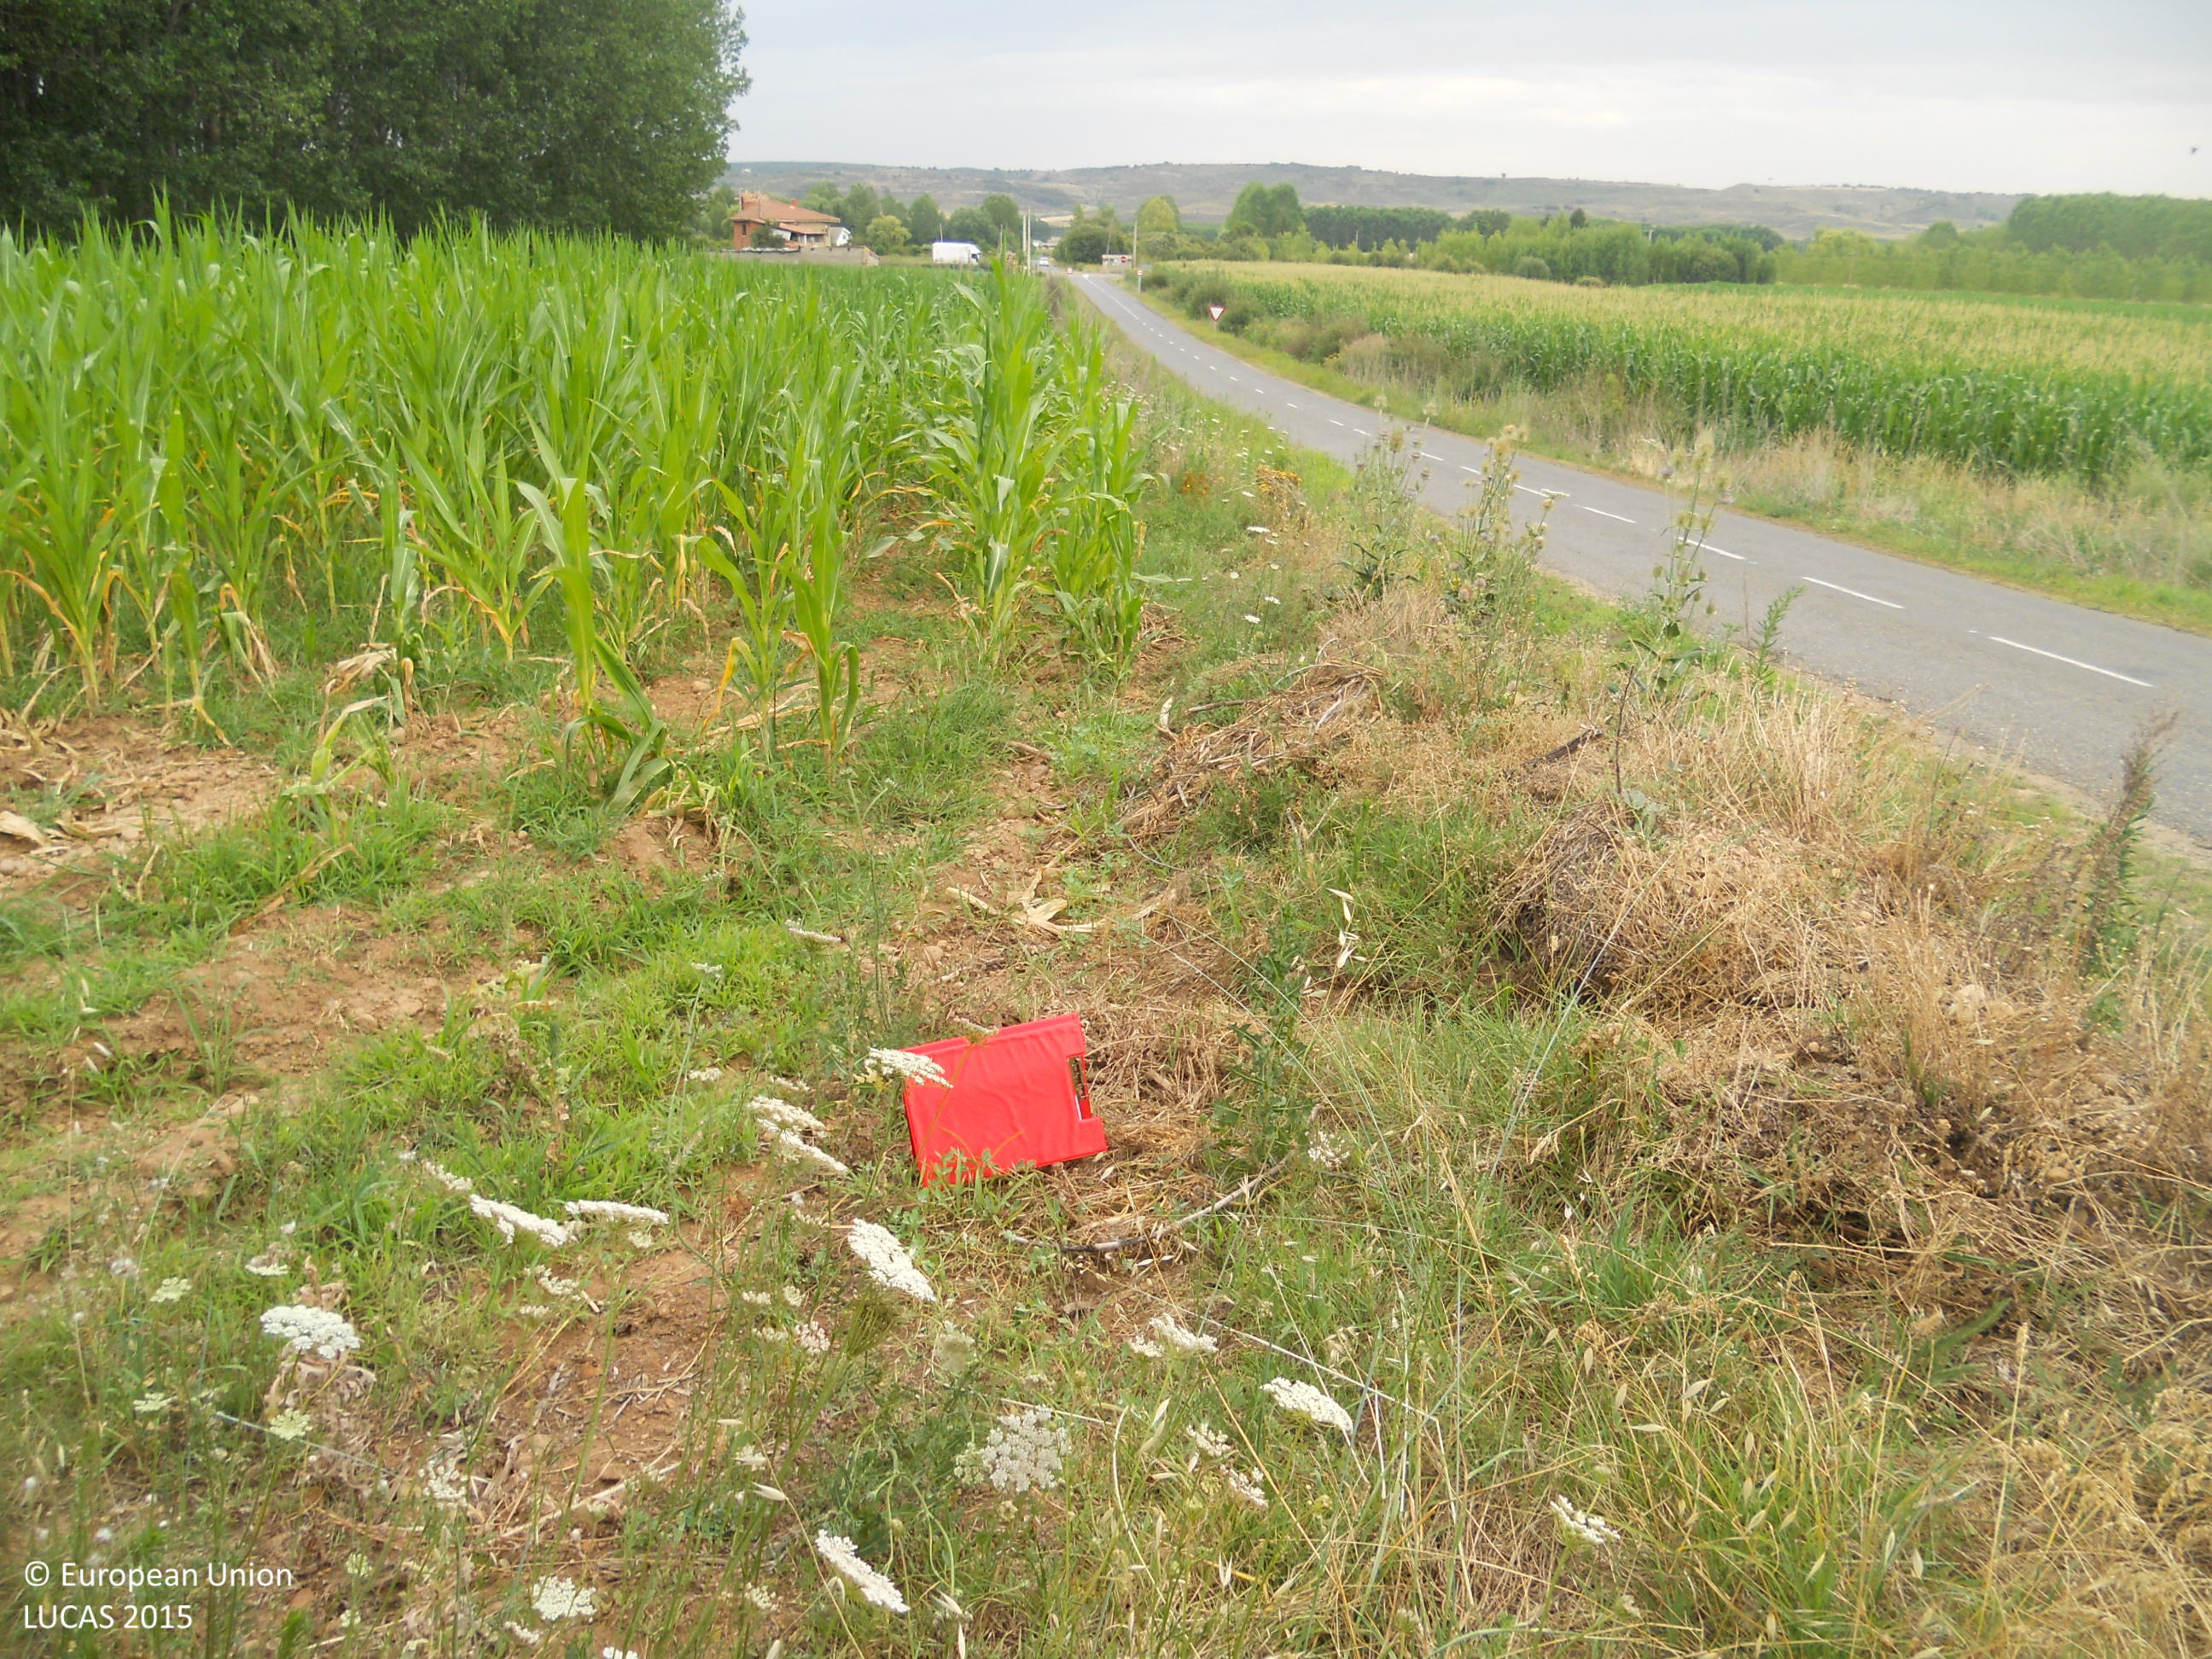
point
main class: Cropland
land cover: Maize
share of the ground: > 75 %
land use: Agriculture (excluding fallow land and kitchen gardens)
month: July
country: ES
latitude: 42.6424
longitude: -5.4004
